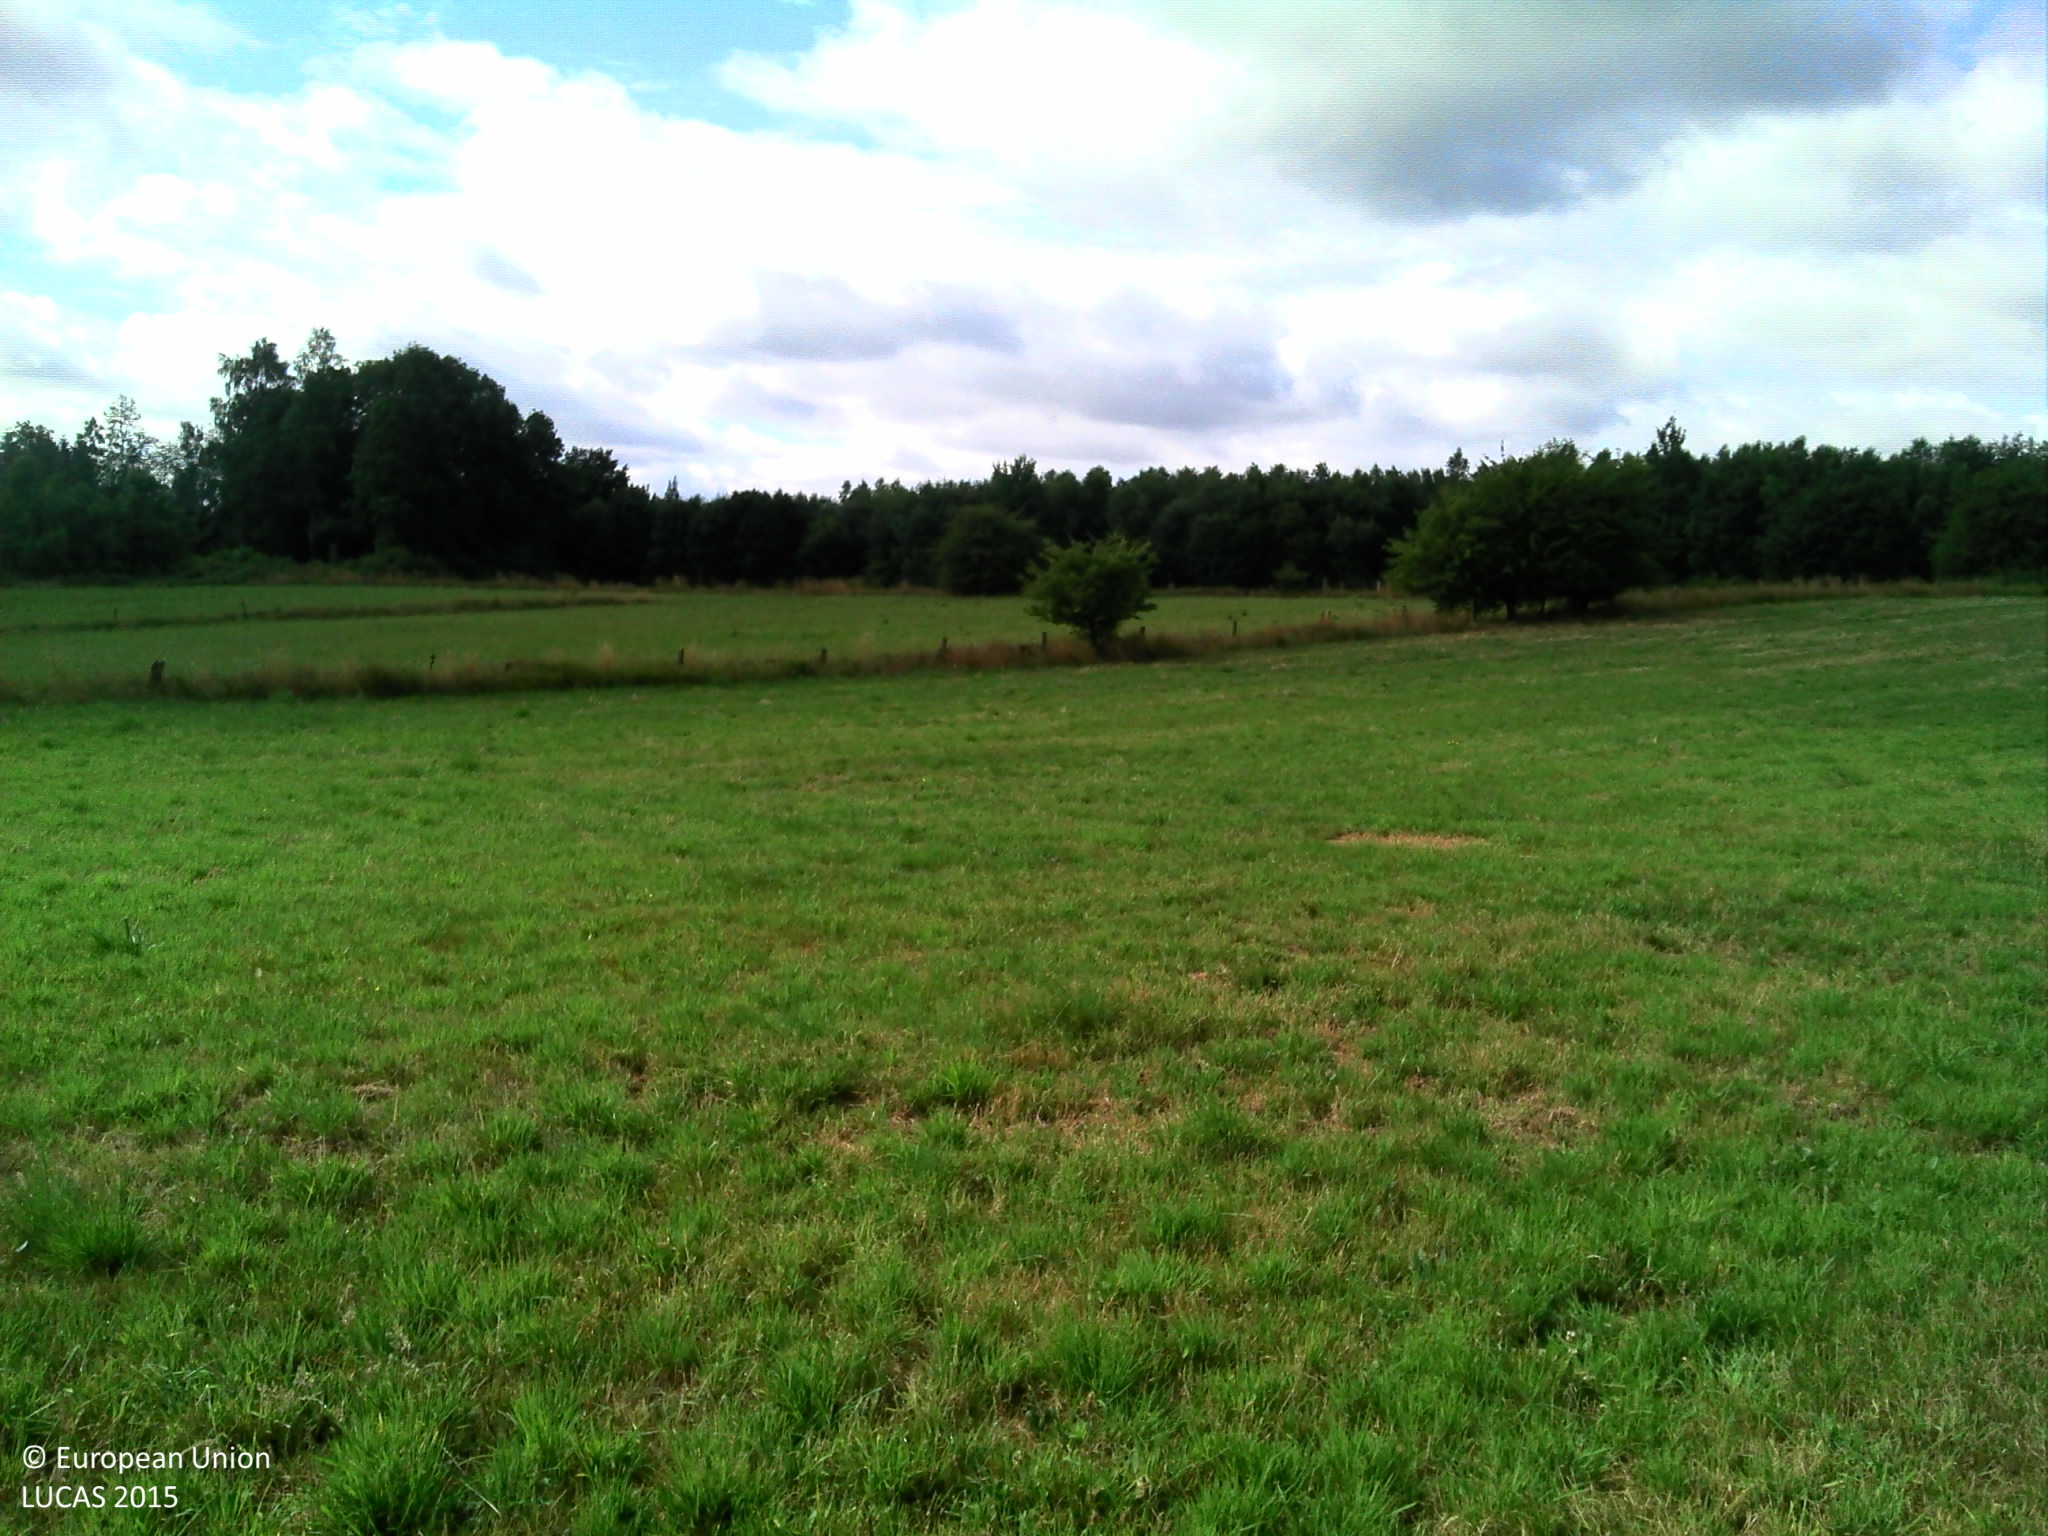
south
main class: Grassland
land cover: Grassland without tree/shrub cover
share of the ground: > 75 %
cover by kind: herbaceous plants 100 %
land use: Agriculture (excluding fallow land and kitchen gardens)
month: July
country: BE
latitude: 49.6922
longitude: 5.3265
